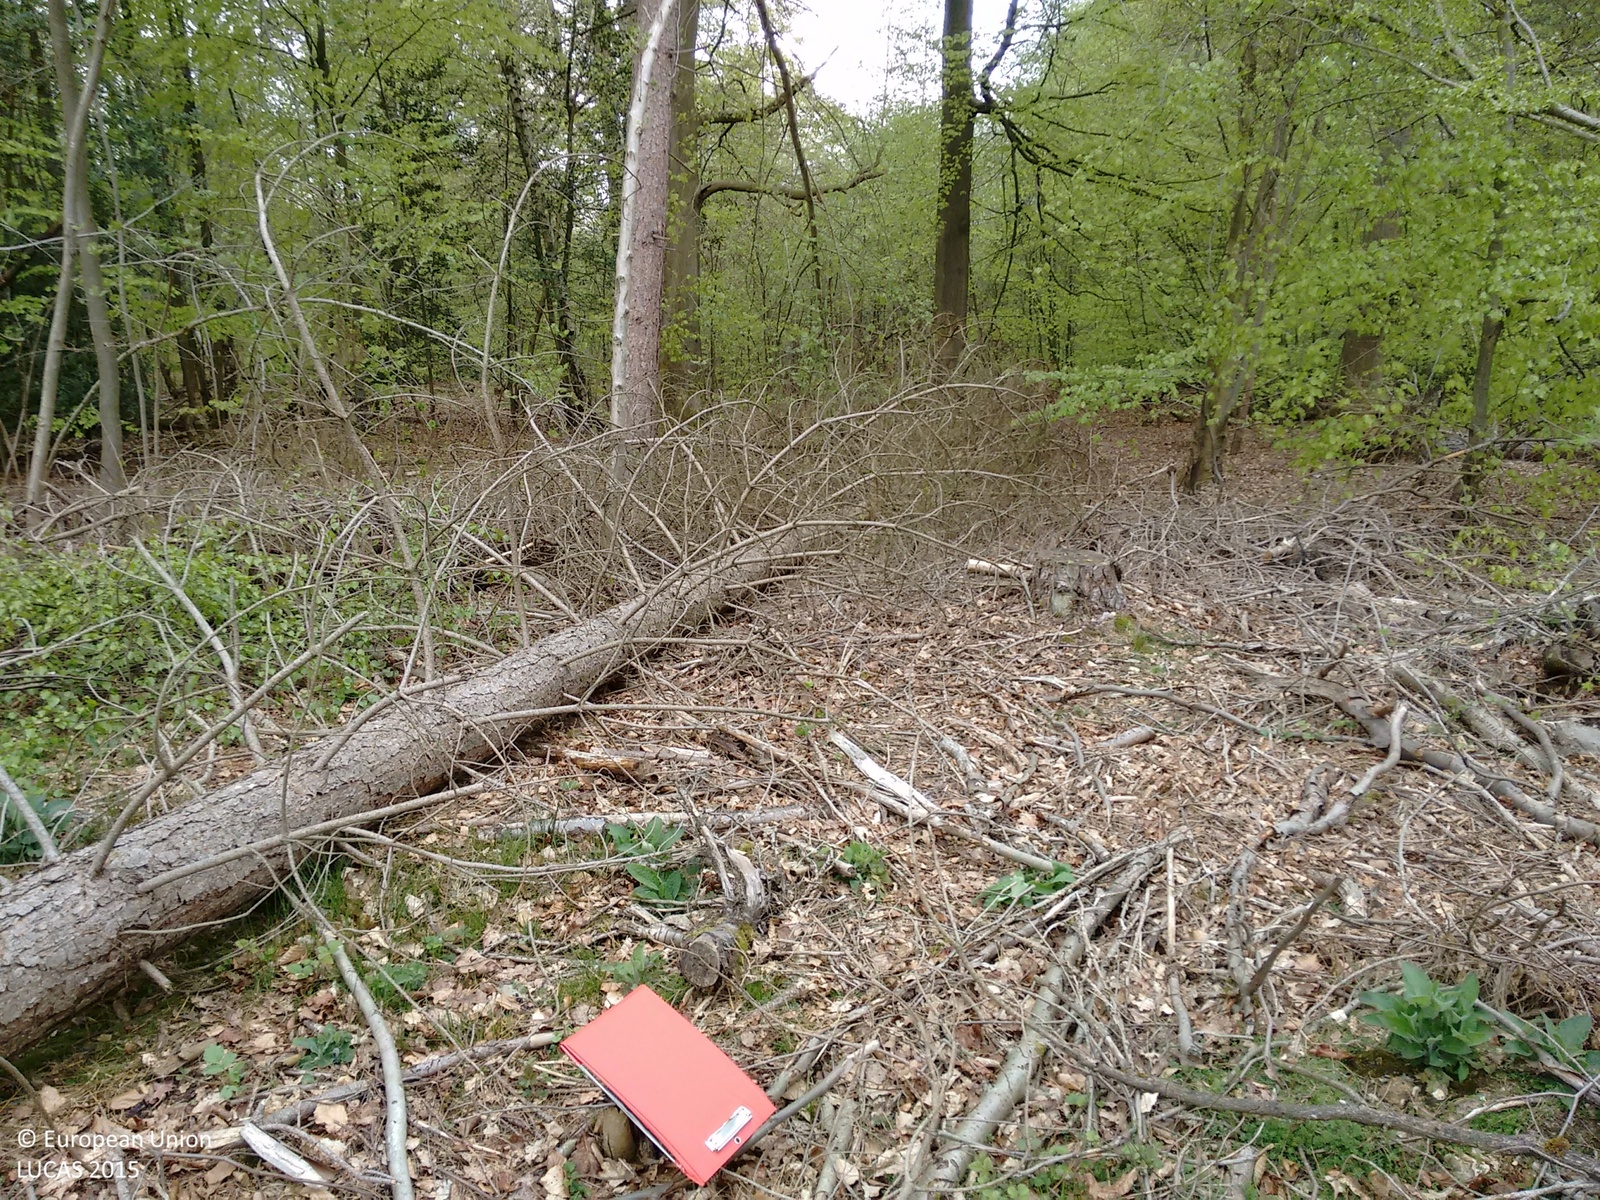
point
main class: Woodland
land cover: Pine dominated mixed woodland
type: mesophytic deciduous forest
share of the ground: 50 - 75 %
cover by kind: coniferous forest trees 60 %, broadleaved forest trees 30 %, shrubs 10 %
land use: Forestry
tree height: > 5 m
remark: Clear cut
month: April
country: GB
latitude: 51.6597
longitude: -0.6656
